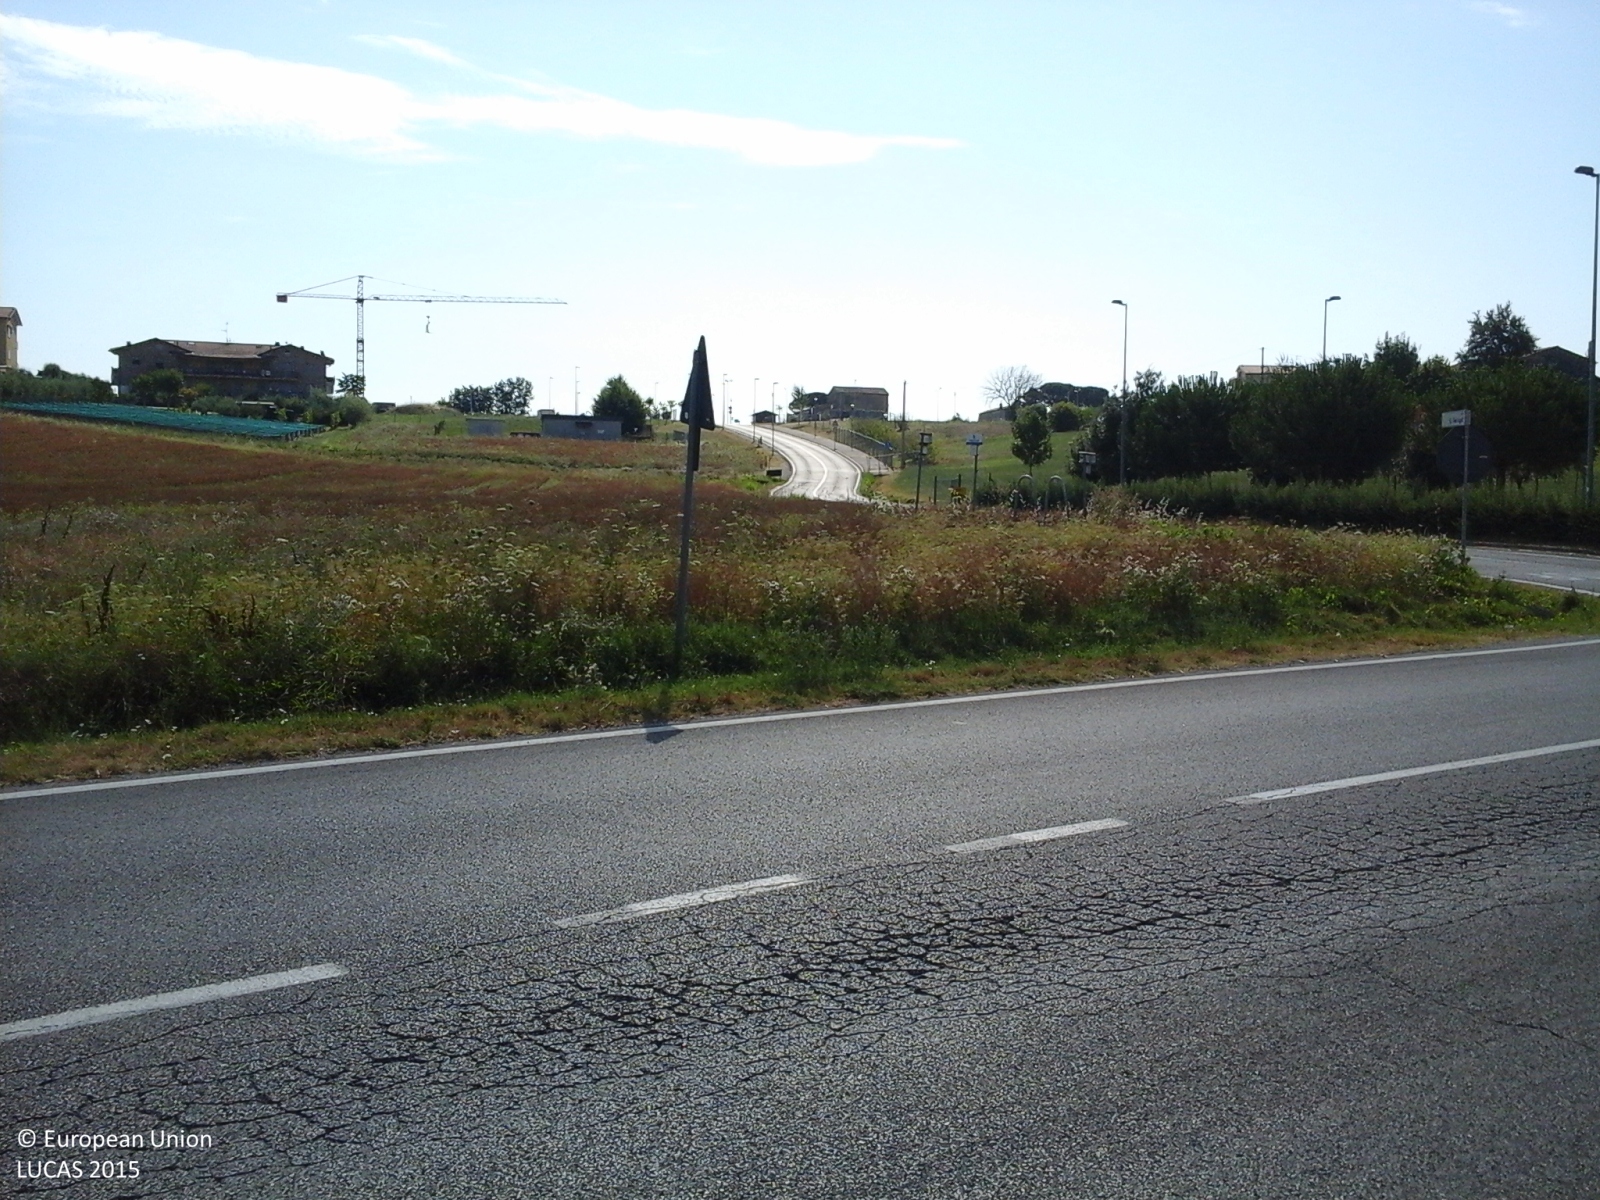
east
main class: Grassland
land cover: Grassland without tree/shrub cover
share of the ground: > 75 %
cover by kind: herbaceous plants 100 %
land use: Manufacturing of textile products
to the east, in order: Grassland without tree/shrub cover; Artificial constructions in urban areas; Grass margins; Ditches and canals; Grass margins; Other non-permanent industrial crops; Artificial constructions in urban areas
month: July
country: IT
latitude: 43.9751
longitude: 12.5993
